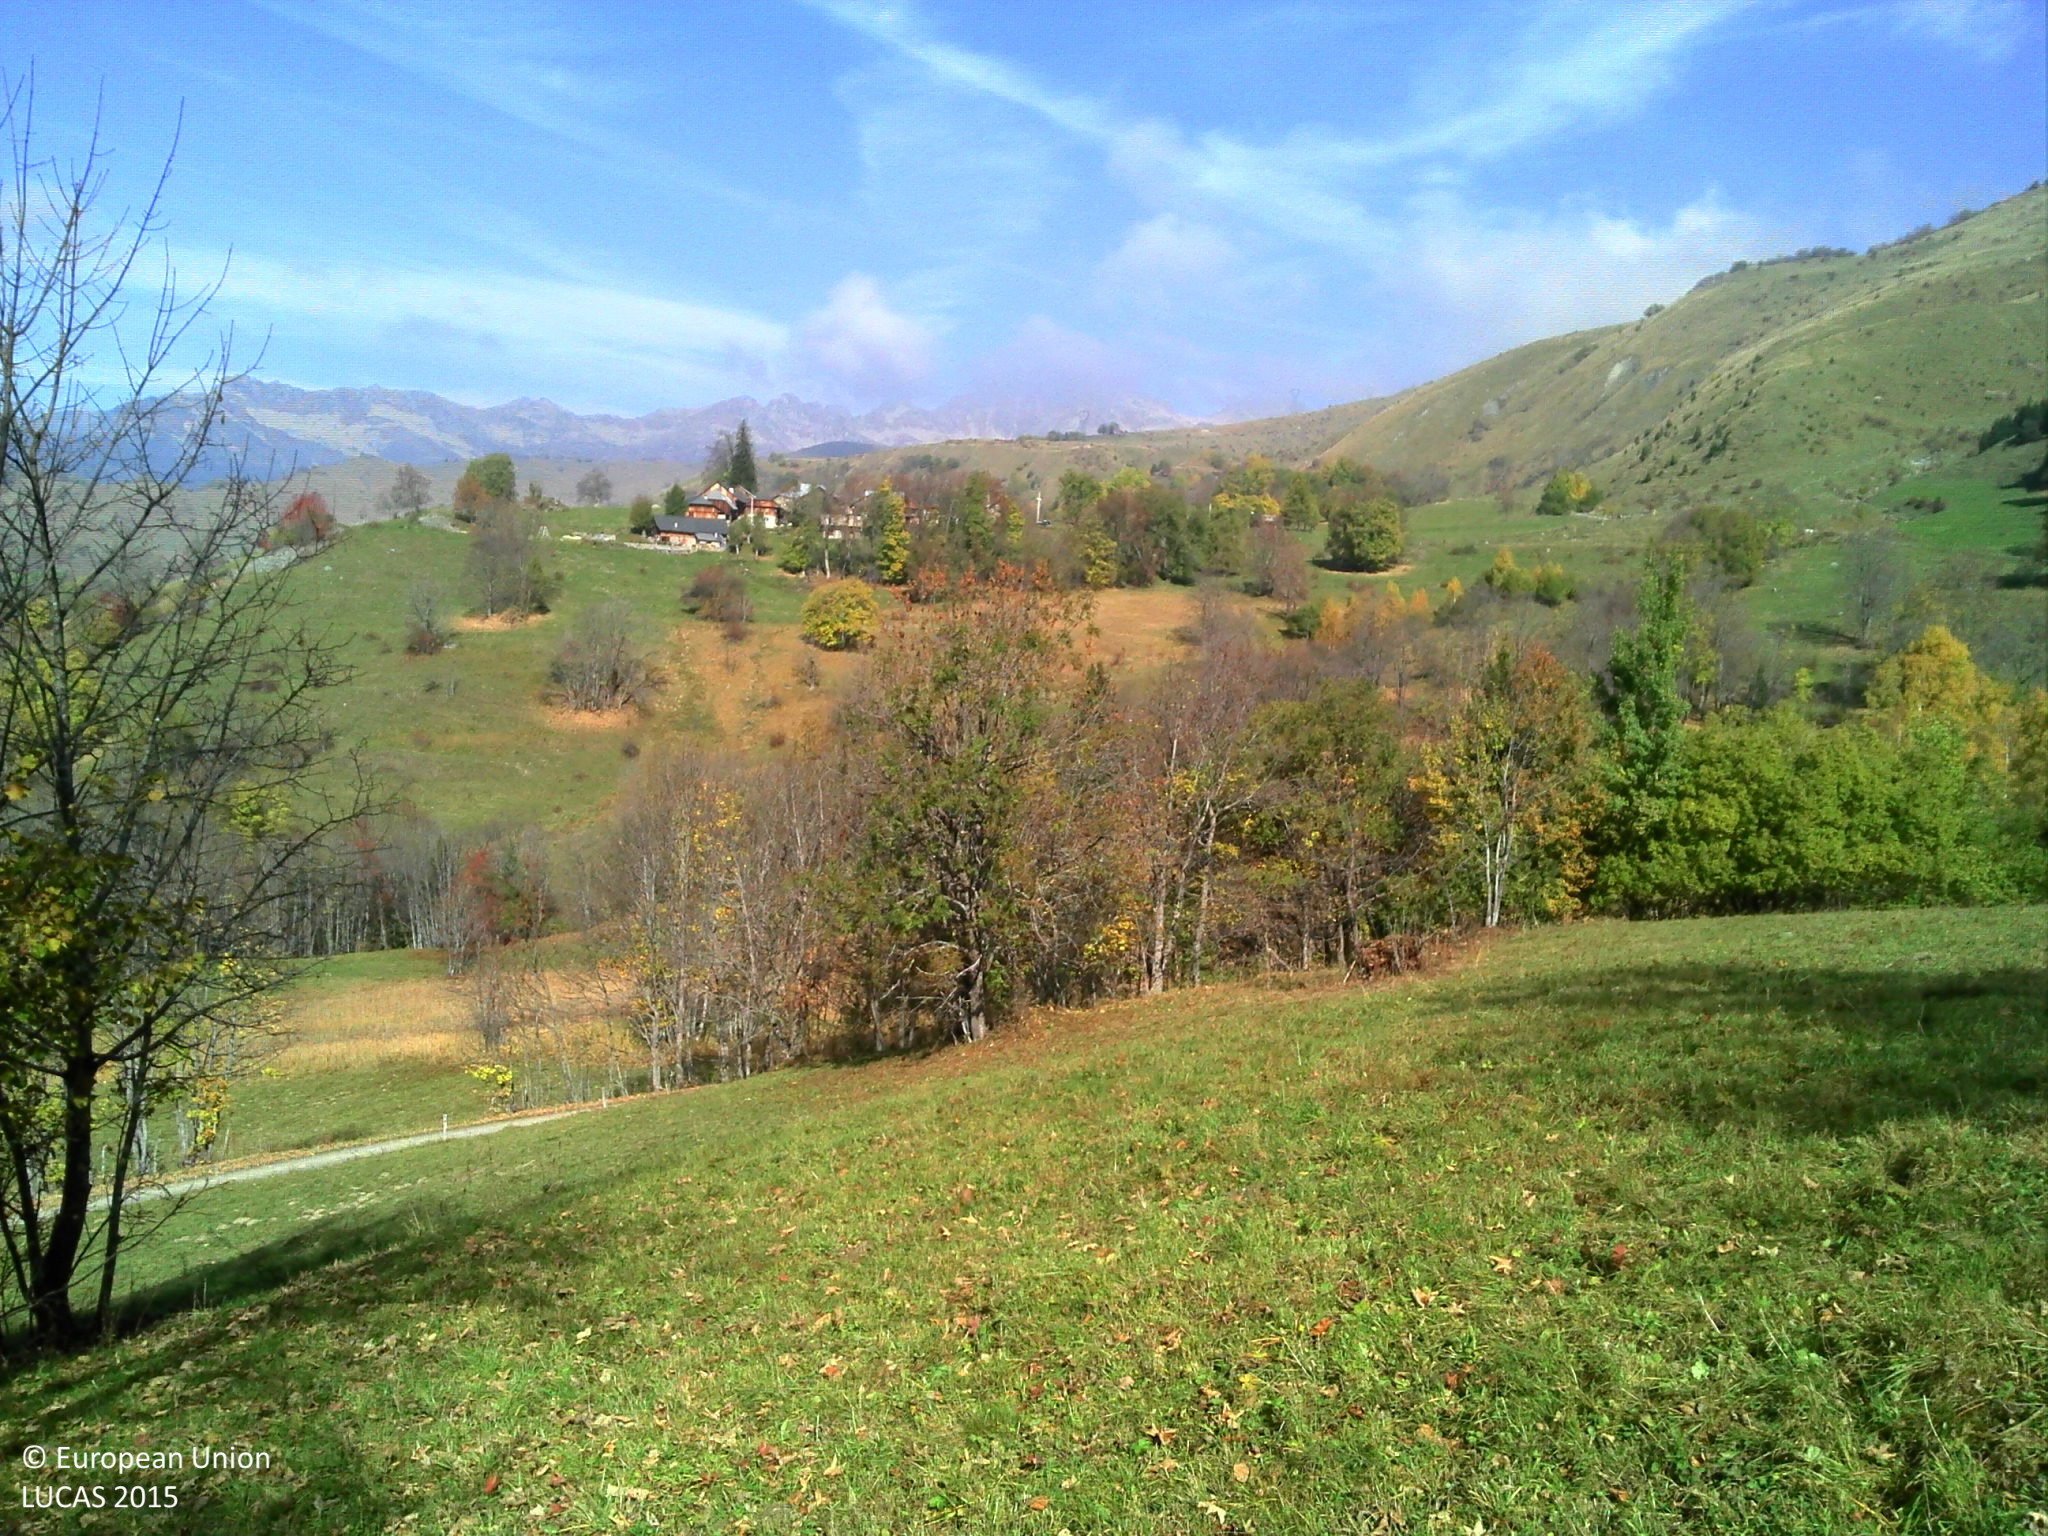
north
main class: Woodland
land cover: Broadleaved woodland
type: mesophytic deciduous forest
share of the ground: 25 - 50 %
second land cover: Grassland without tree/shrub cover
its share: > 75 %
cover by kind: herbaceous plants 70 %, broadleaved forest trees 30 %
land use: Forestry
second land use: Agriculture (excluding fallow land and kitchen gardens)
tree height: > 5 m
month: October
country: FR
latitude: 45.3697
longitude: 6.3659
